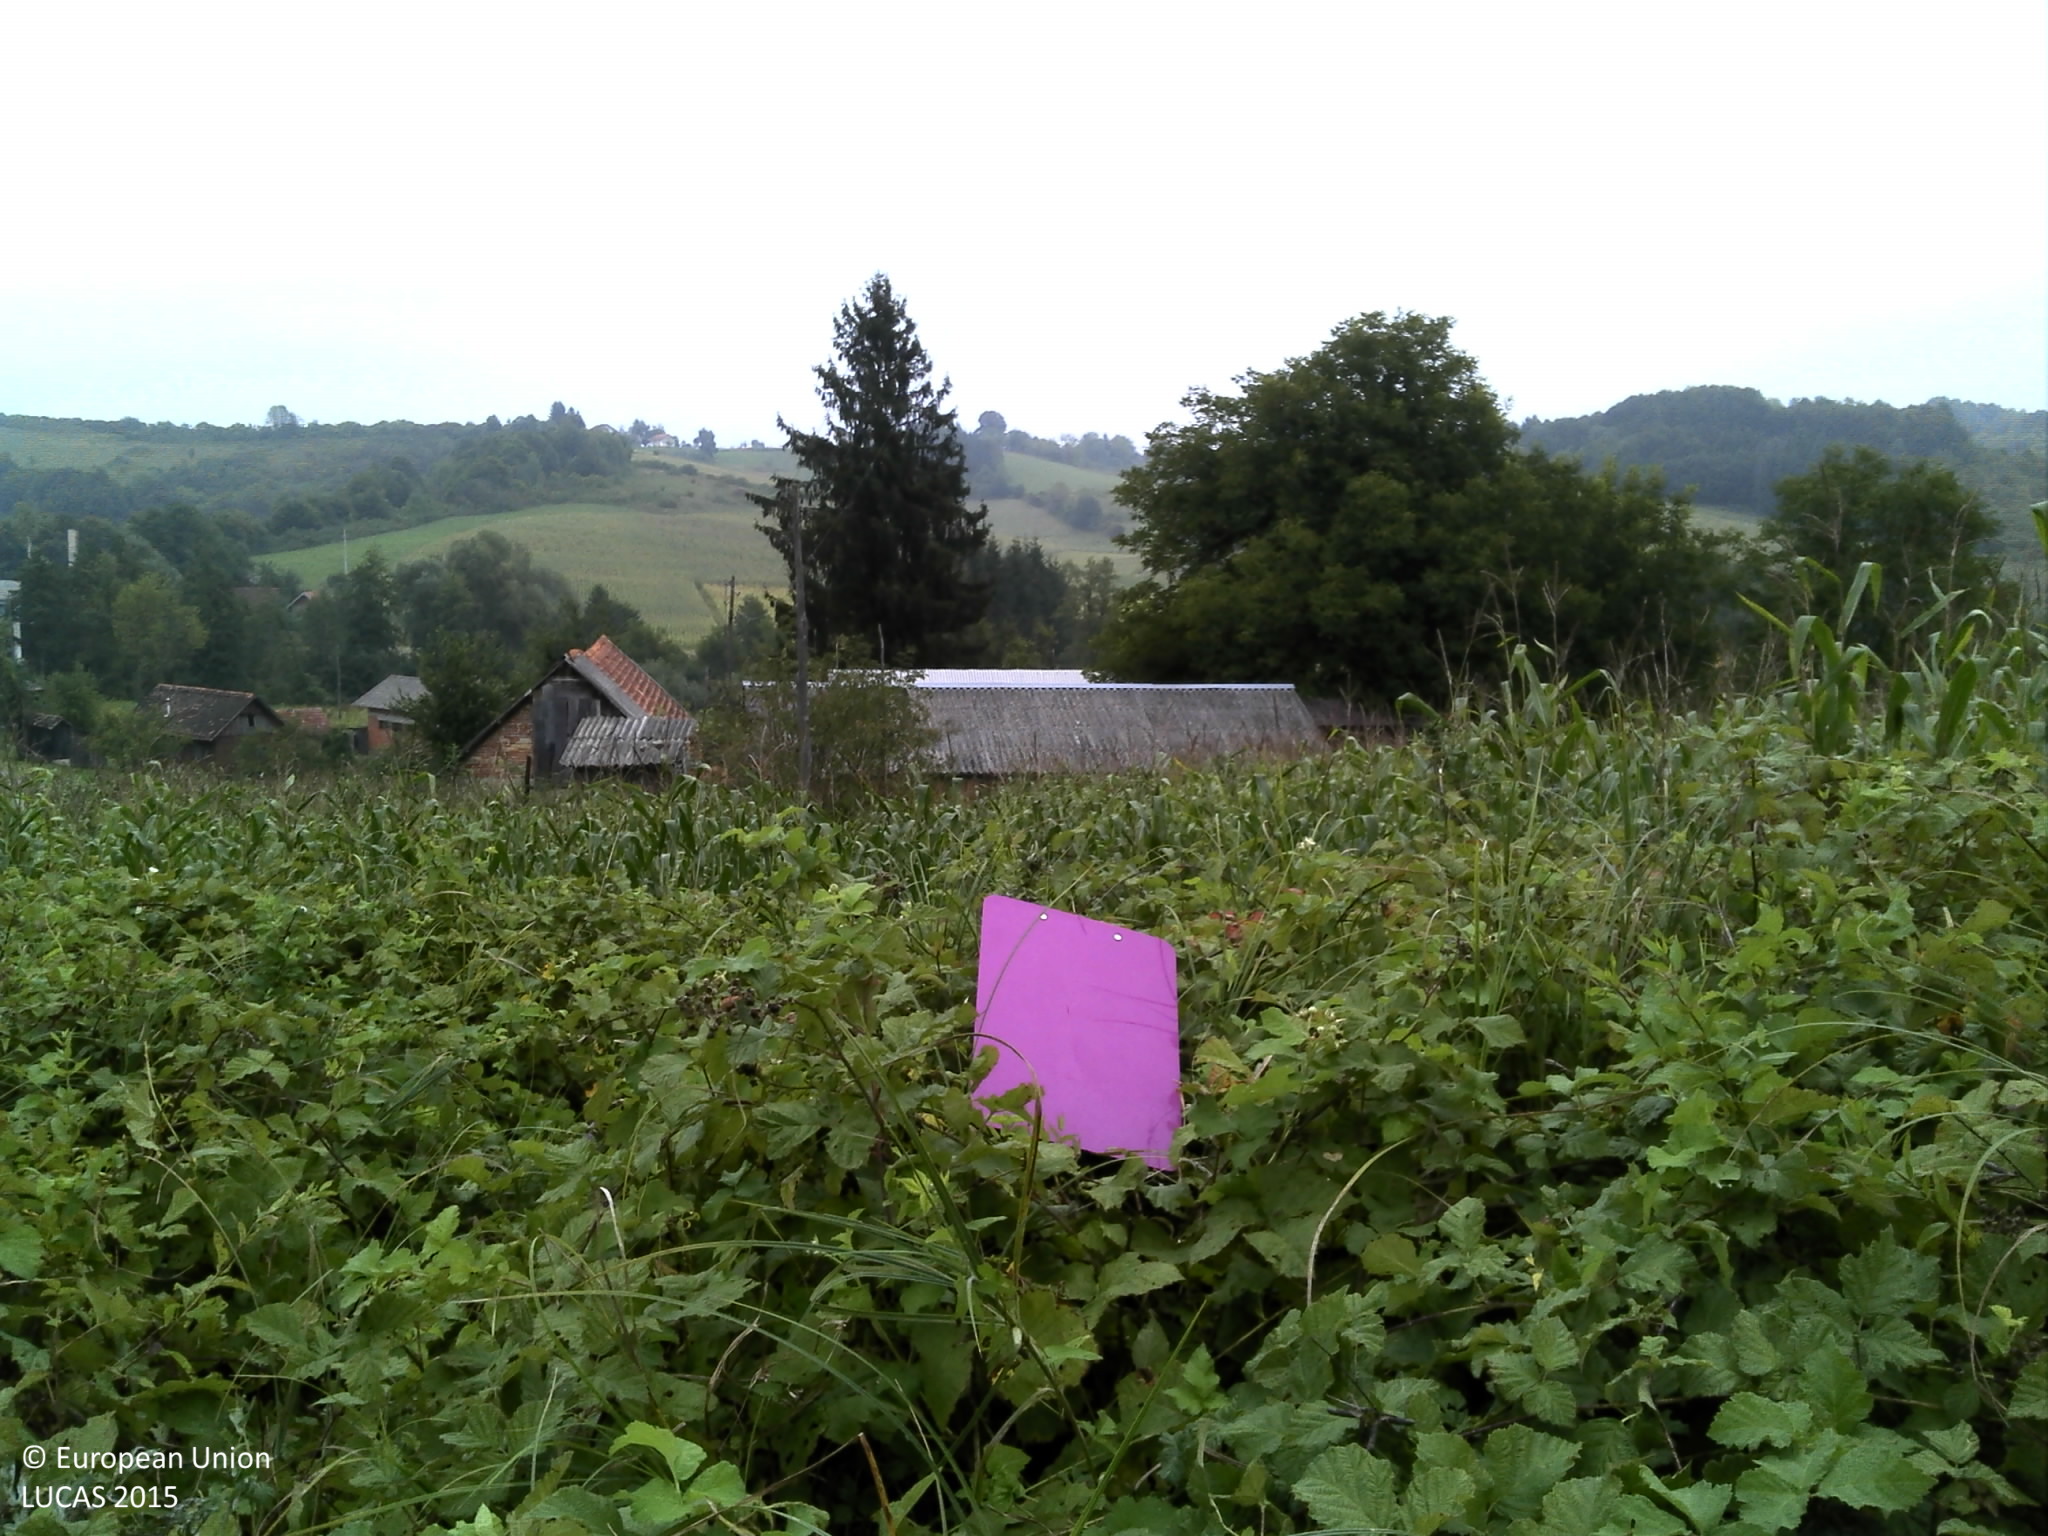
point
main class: Grassland
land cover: Spontaneously vegetated surfaces
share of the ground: > 75 %
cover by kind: herbaceous plants 100 %
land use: Semi-natural and natural areas not in use
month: August
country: HR
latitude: 45.2978
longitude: 15.6706
